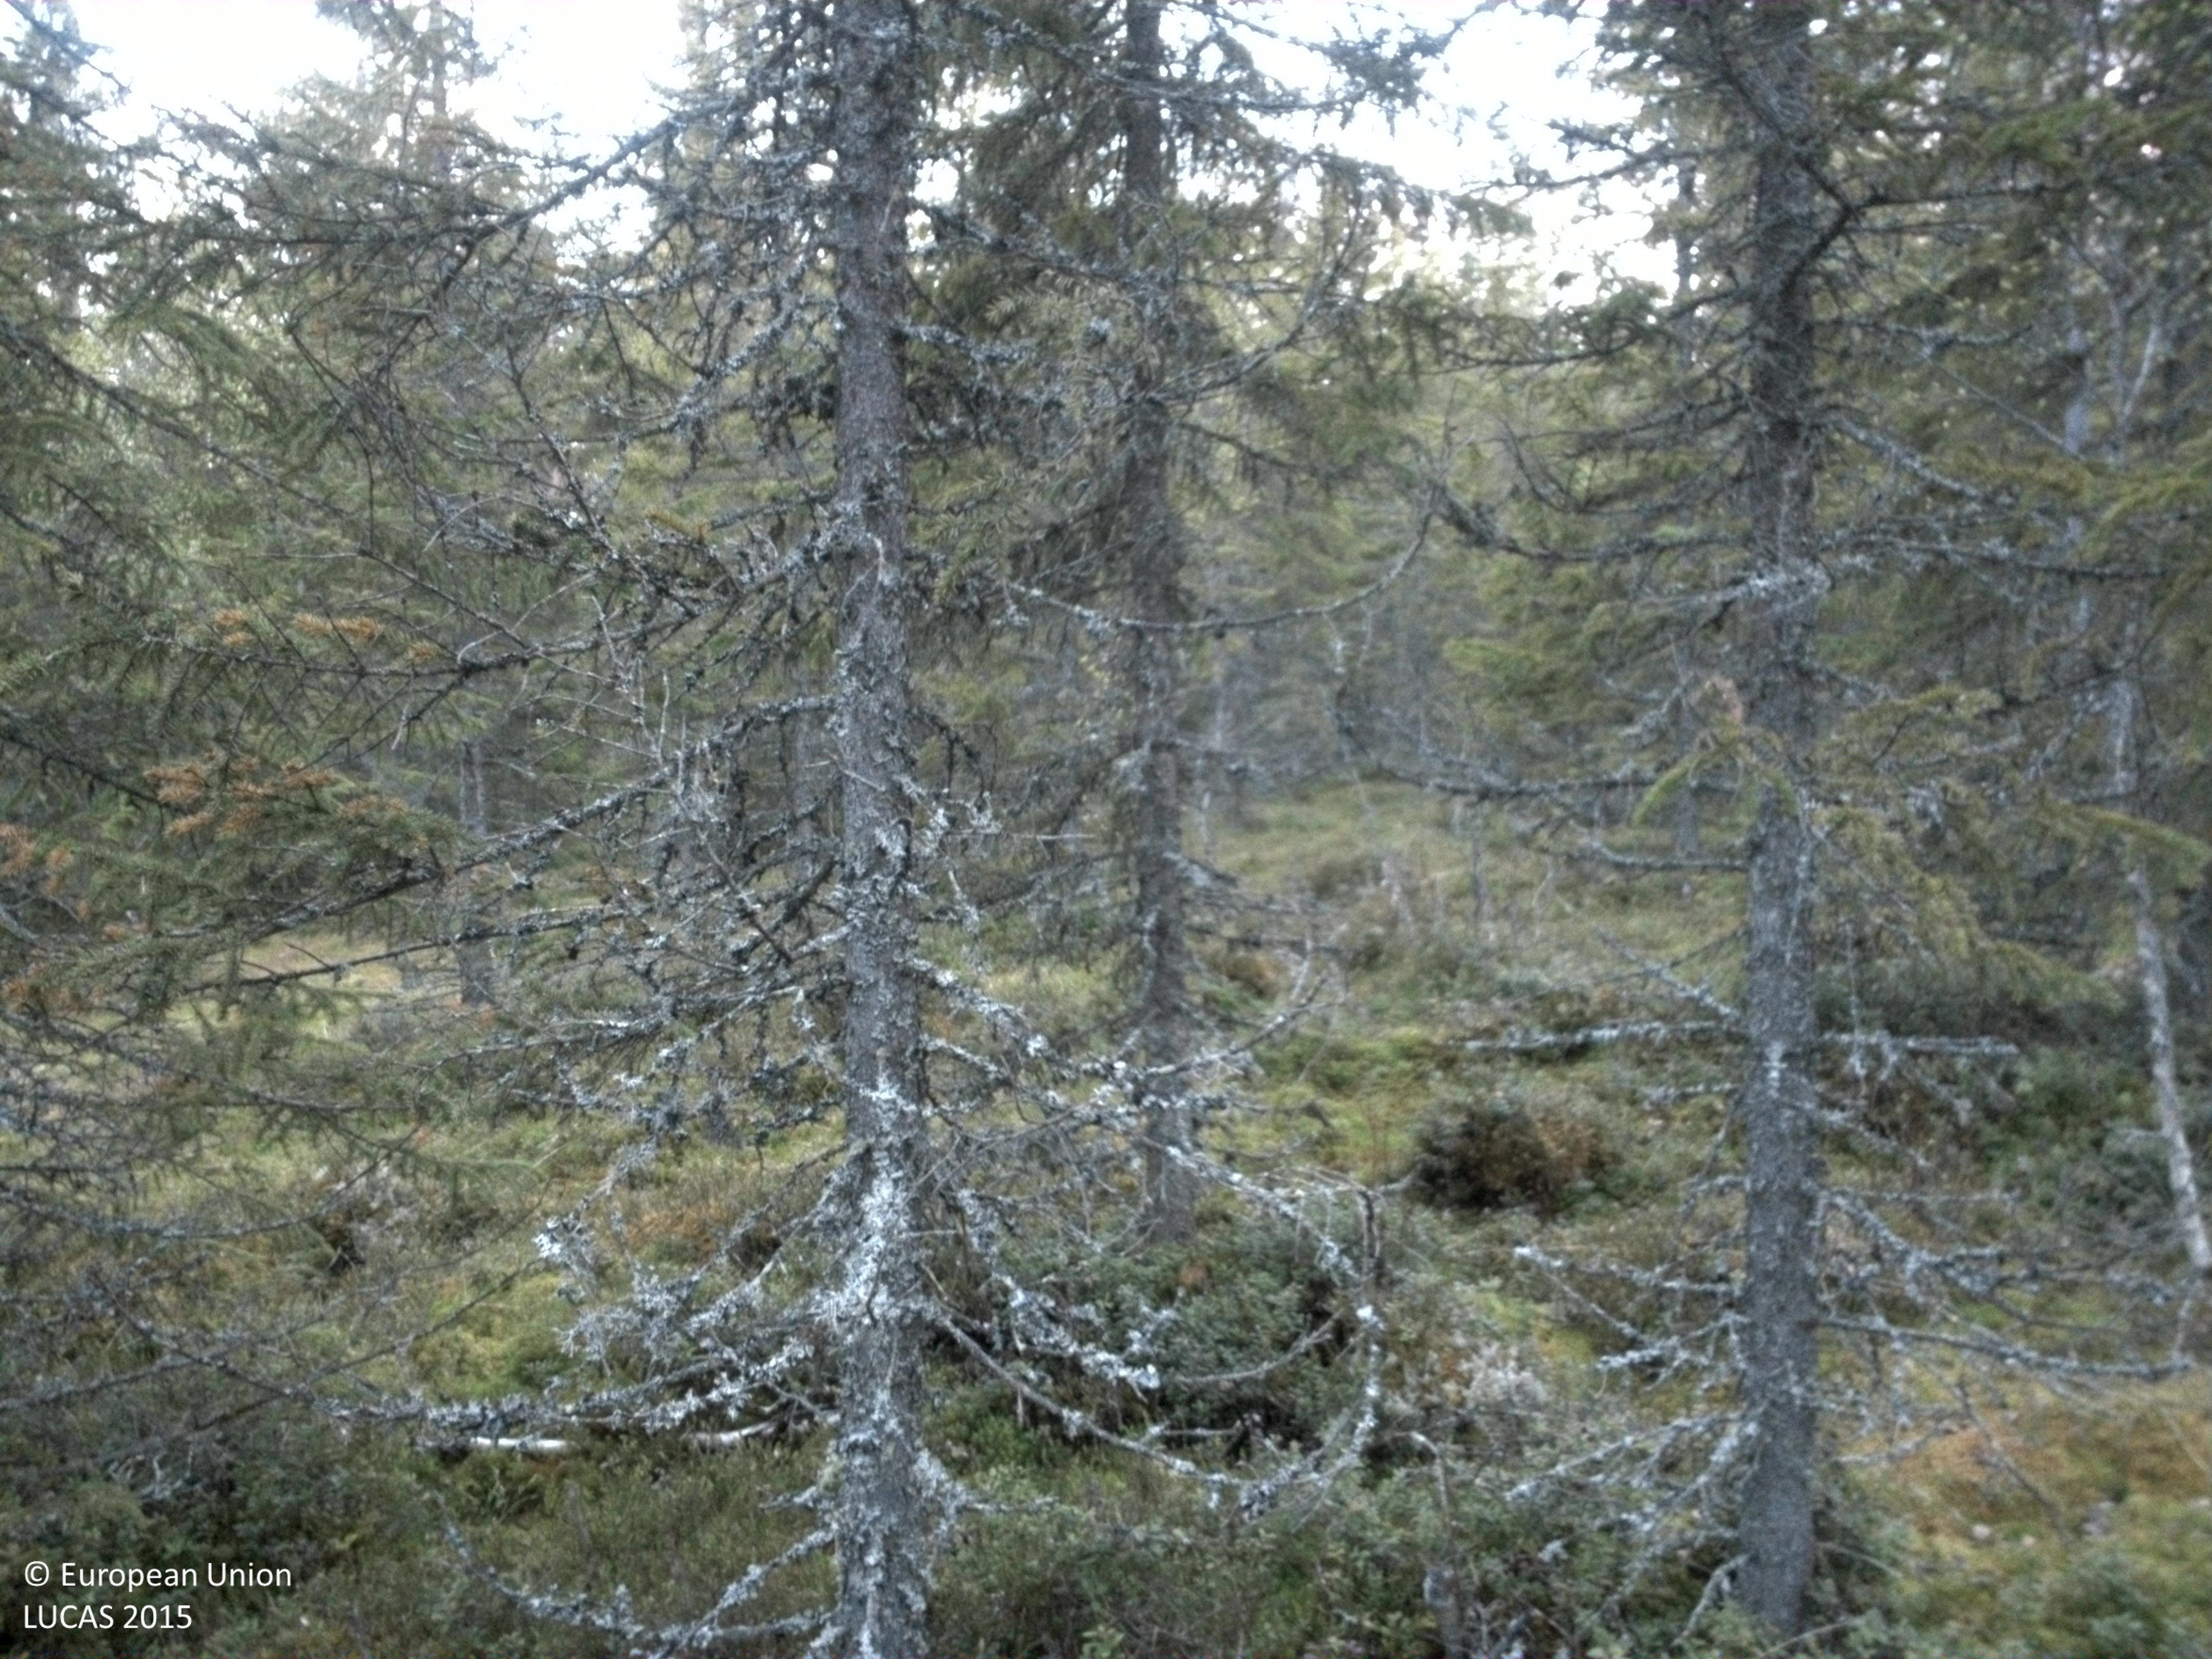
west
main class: Woodland
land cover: Spruce dominated coniferous woodland
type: boreal forest
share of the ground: > 75 %
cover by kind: coniferous forest trees 80 %, shrubs 20 %
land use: Forestry
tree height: > 5 m
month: May
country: SE
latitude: 60.9346
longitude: 12.4089
